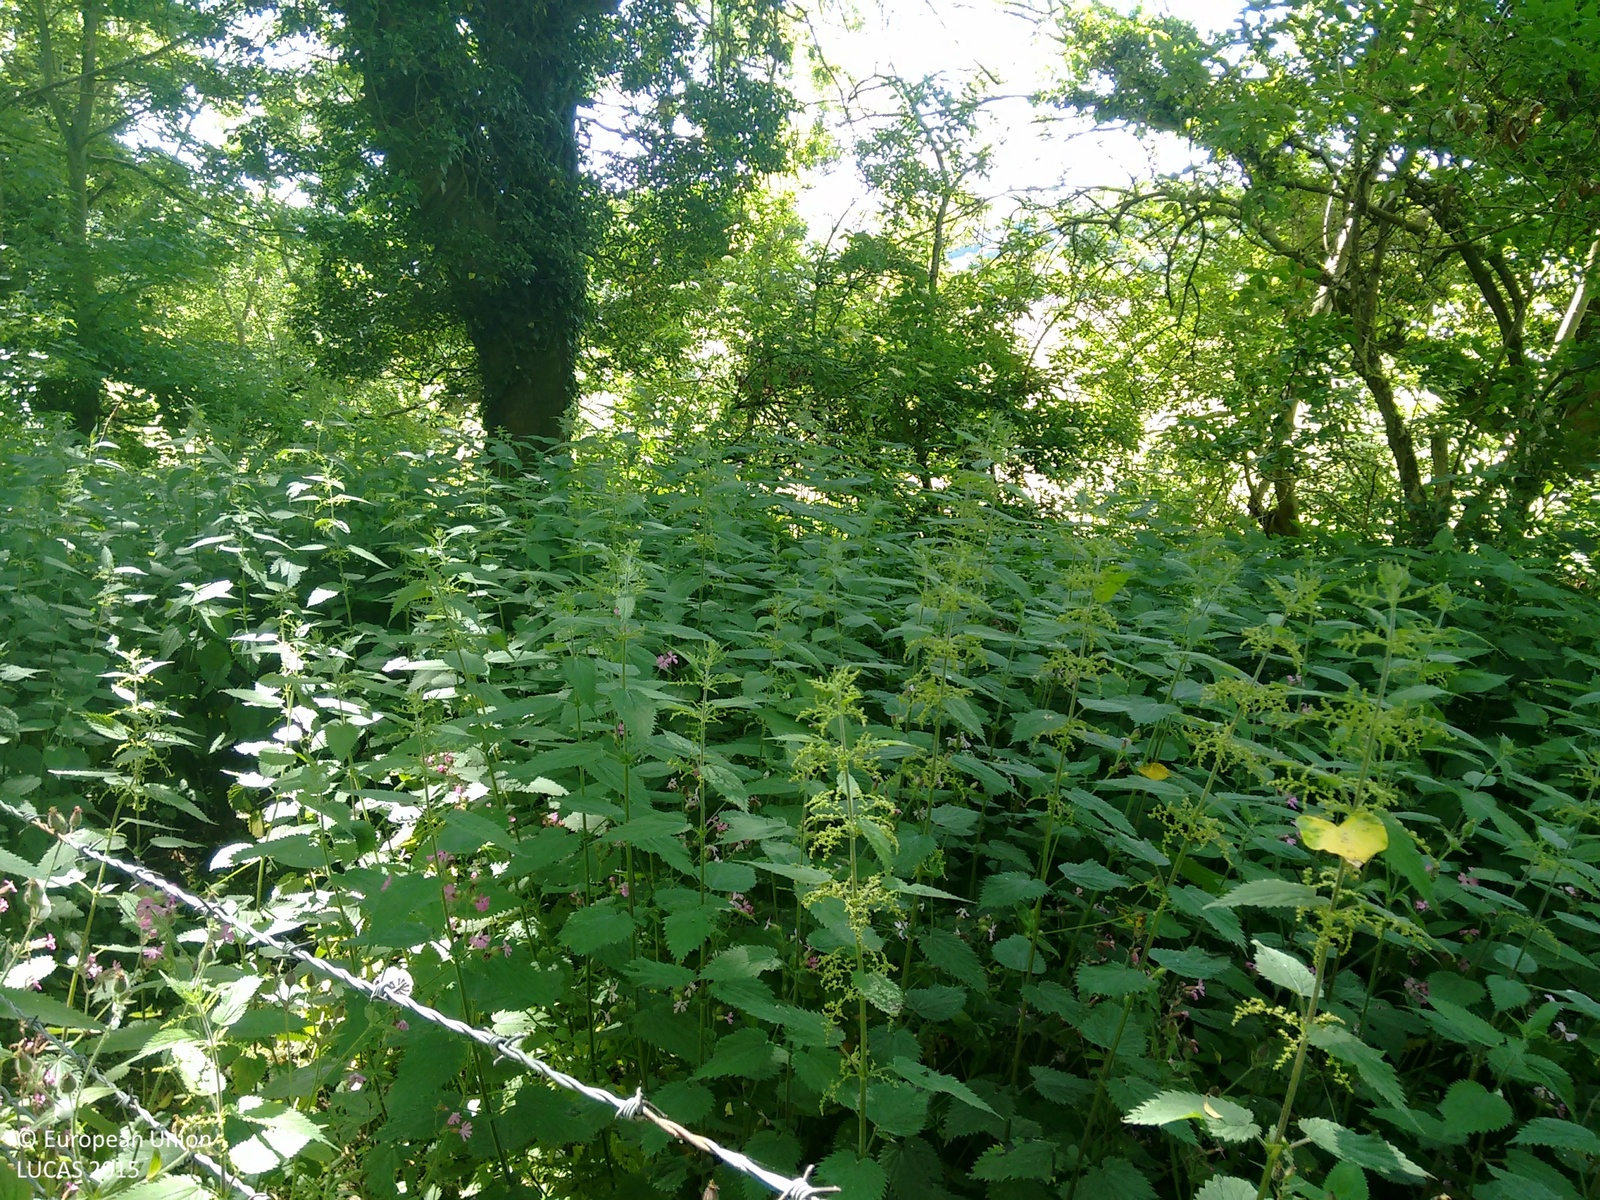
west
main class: Woodland
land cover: Broadleaved woodland
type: mesophytic deciduous forest
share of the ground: > 75 %
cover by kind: broadleaved forest trees 75 %, shrubs 15 %, herbaceous plants 10 %
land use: Semi-natural and natural areas not in use
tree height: > 5 m
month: June
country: GB
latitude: 50.7956
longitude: 0.2229
